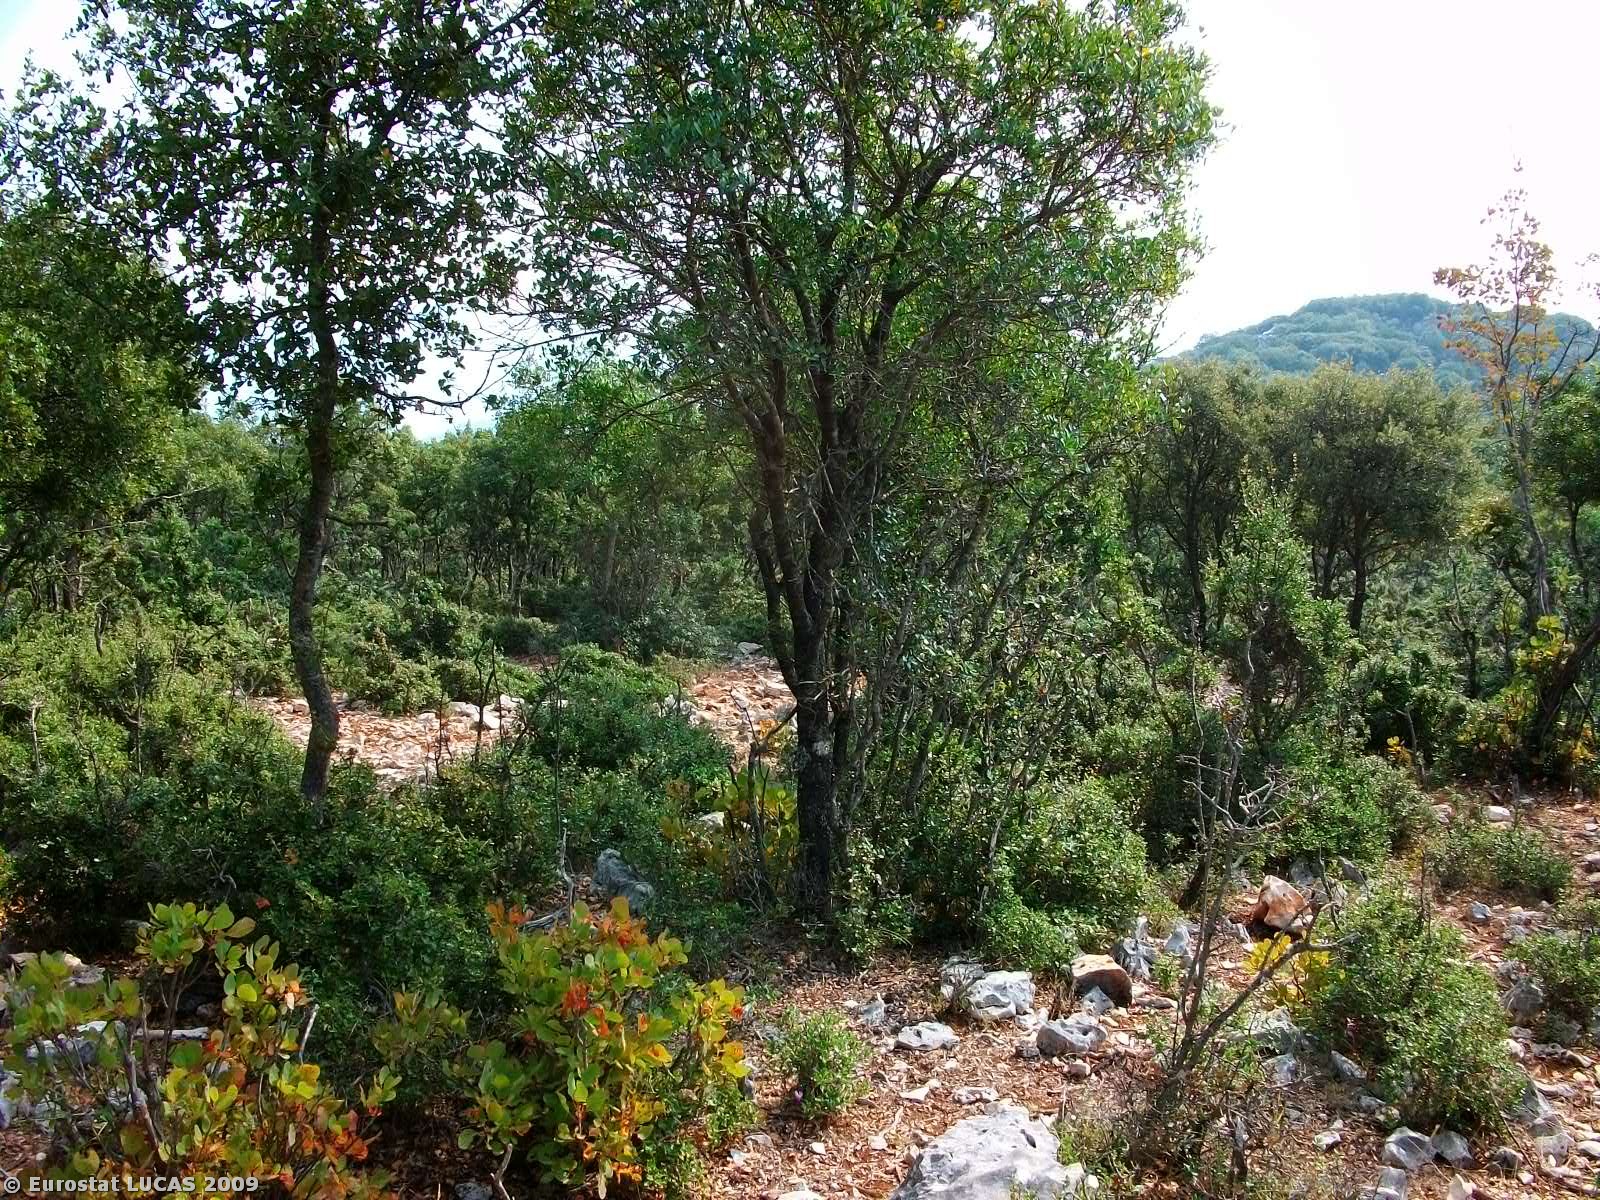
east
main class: Shrubland
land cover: Shrubland with sparse tree cover
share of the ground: 50 - 75 %
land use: Agriculture (excluding fallow land and kitchen gardens)
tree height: < 5 m
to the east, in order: Shrubland with sparse tree cover; Broadleaved woodland; Shrubland with sparse tree cover
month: October
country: GR
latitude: 39.3584
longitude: 20.4762
